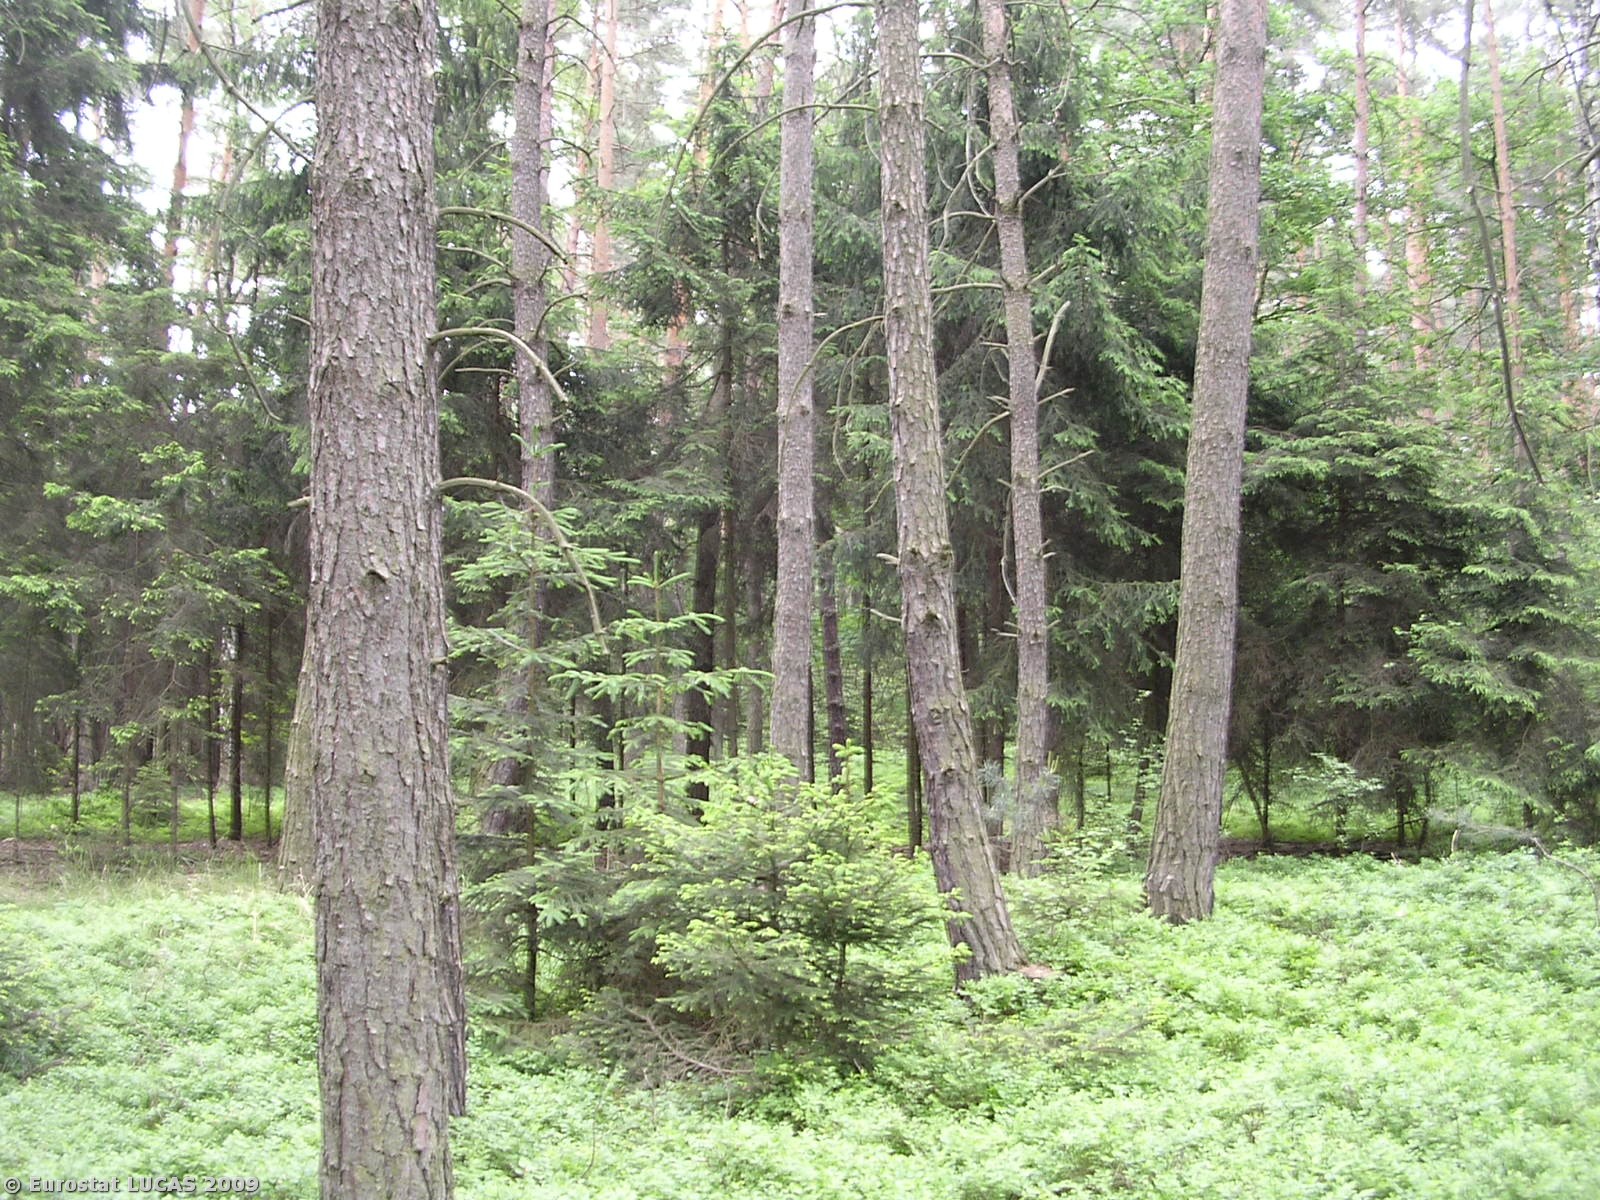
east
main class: Woodland
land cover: Coniferous woodland
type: hemiboreal forest and nemoral coniferous forest and mixed broadleaved-coniferous forest
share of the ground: > 75 %
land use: Forestry
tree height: > 5 m
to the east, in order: Coniferous woodland; Tracks; Coniferous woodland
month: May
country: CZ
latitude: 50.3426
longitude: 14.6250
